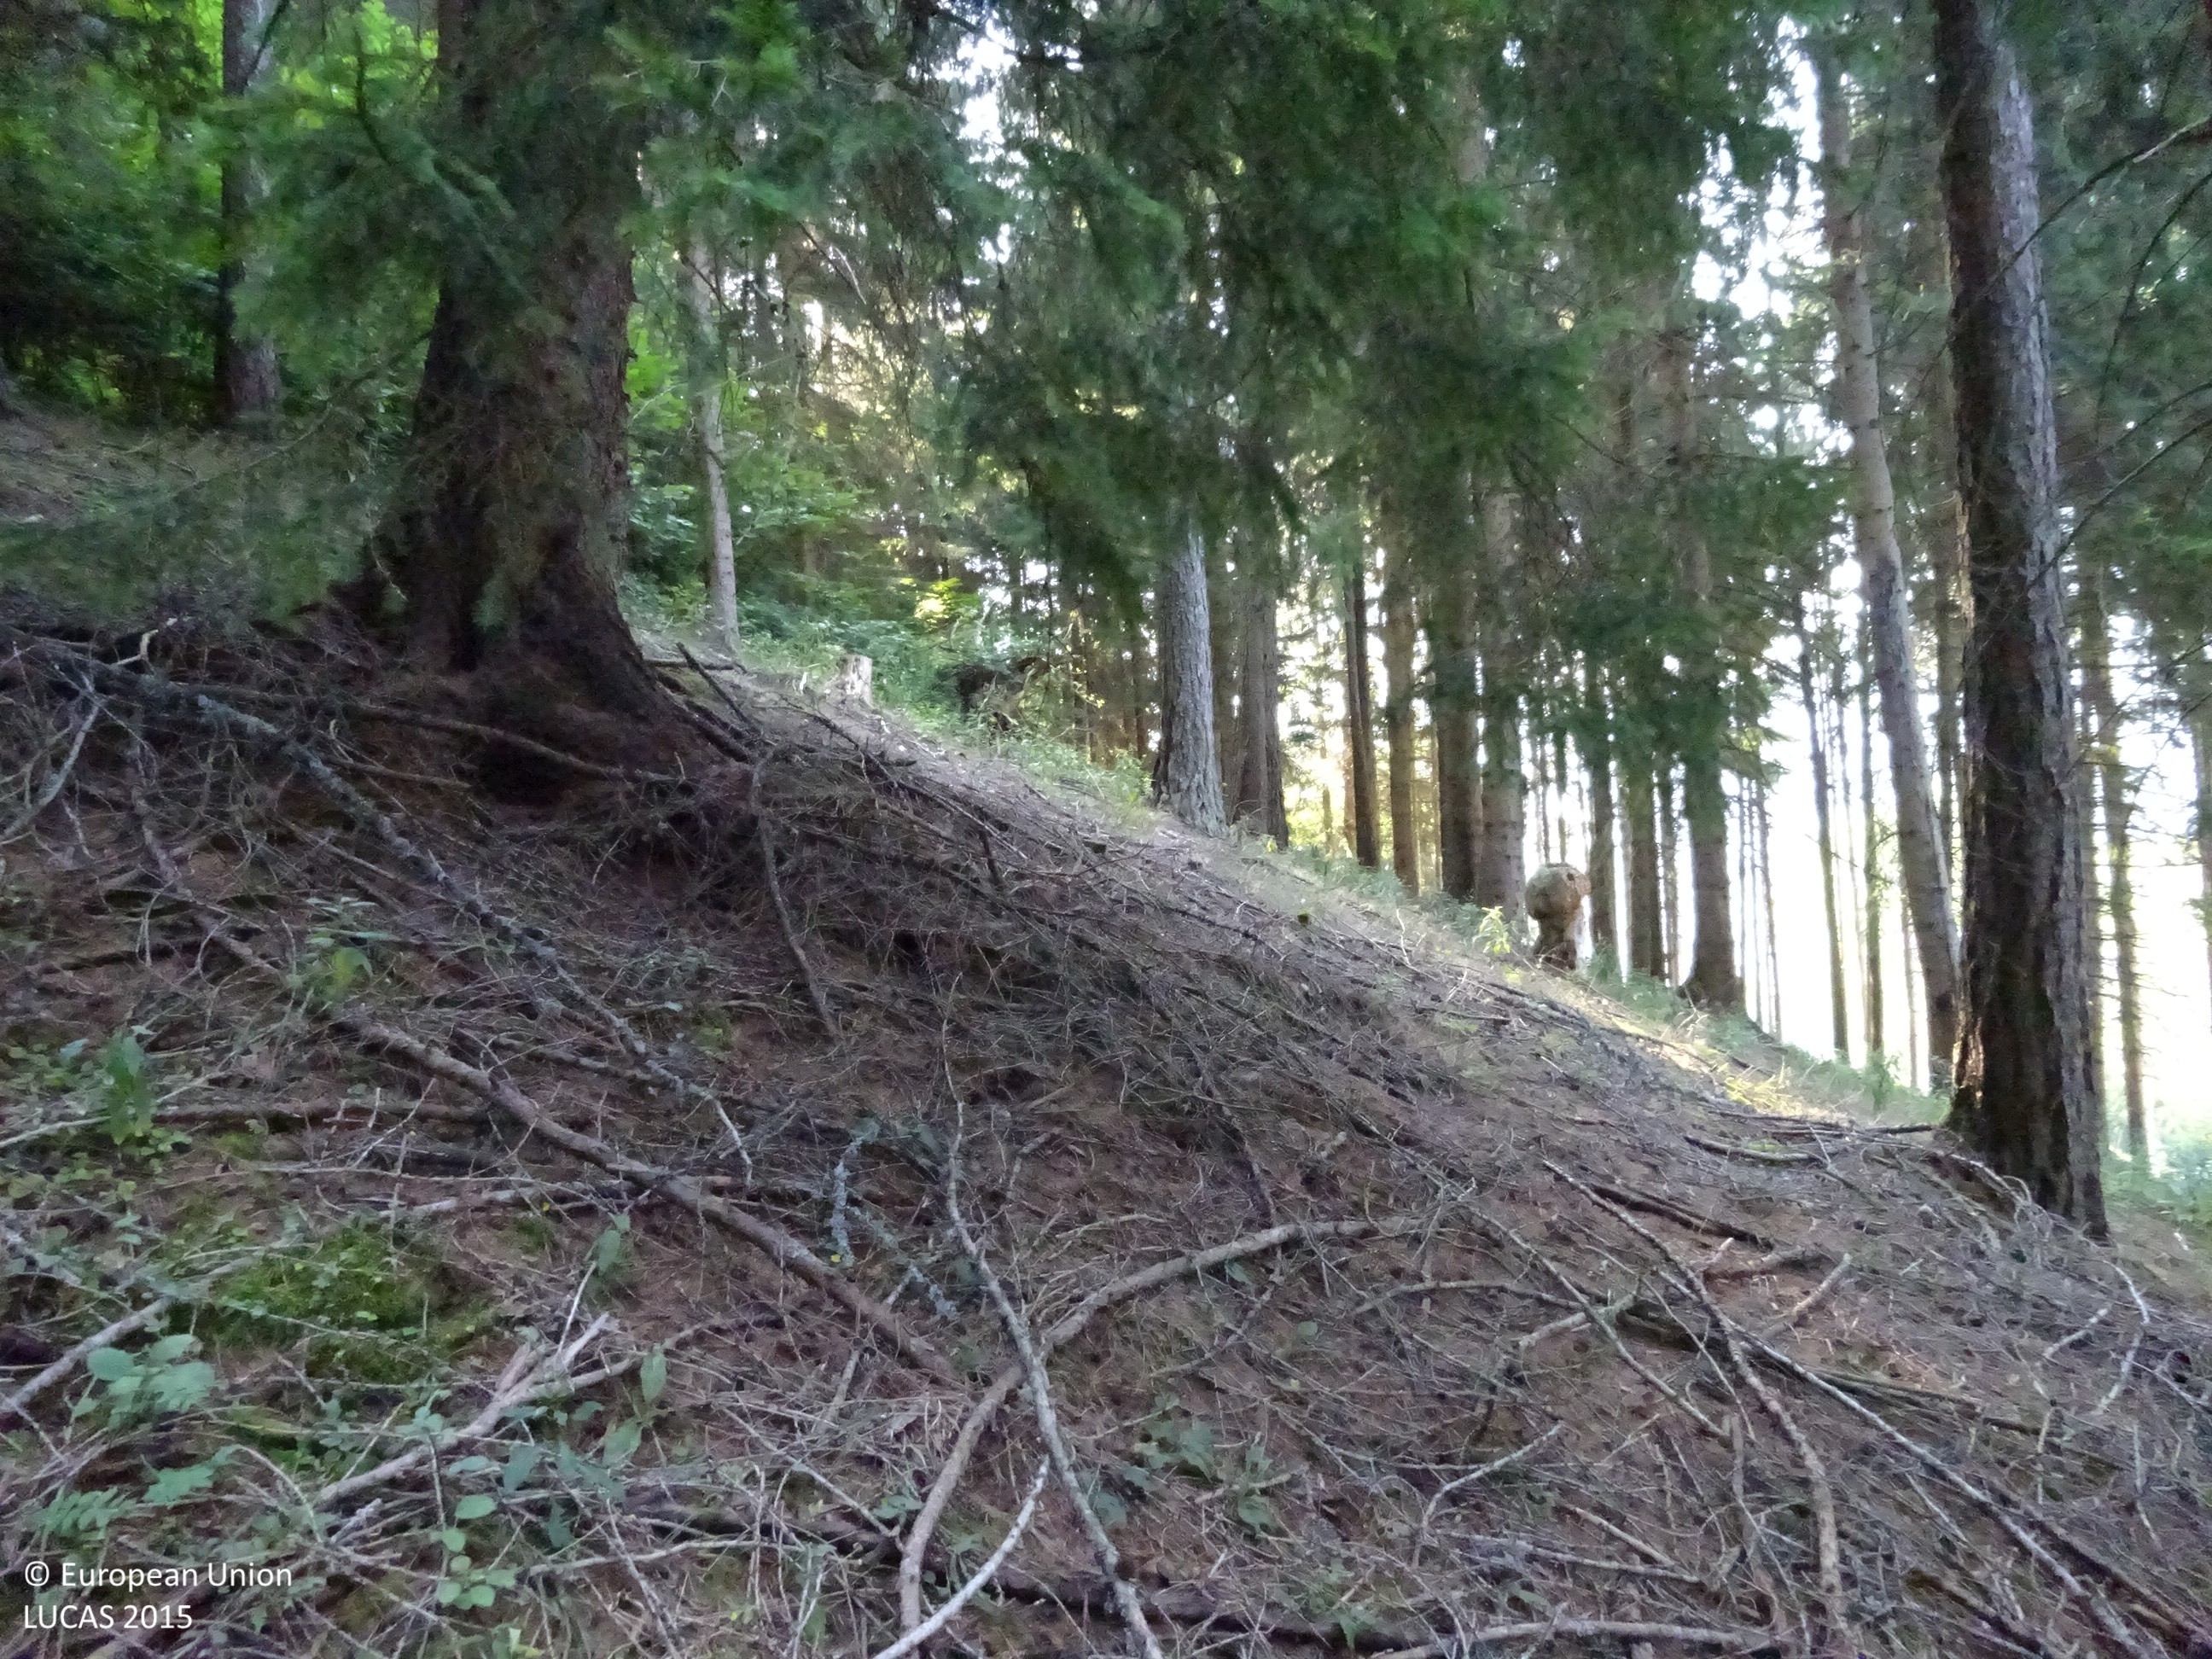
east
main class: Woodland
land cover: Other coniferous woodland
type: alpine coniferous forest
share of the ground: > 75 %
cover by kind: coniferous forest trees 100 %
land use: Forestry
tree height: > 5 m
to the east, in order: Other coniferous woodland; Spruce dominated coniferous woodland; Fences; Broadleaved woodland; Grassland without tree/shrub cover; Tracks; Grassland without tree/shrub cover; Fences; Spruce dominated coniferous woodland
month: August
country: AT
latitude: 47.4713
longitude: 15.5337
